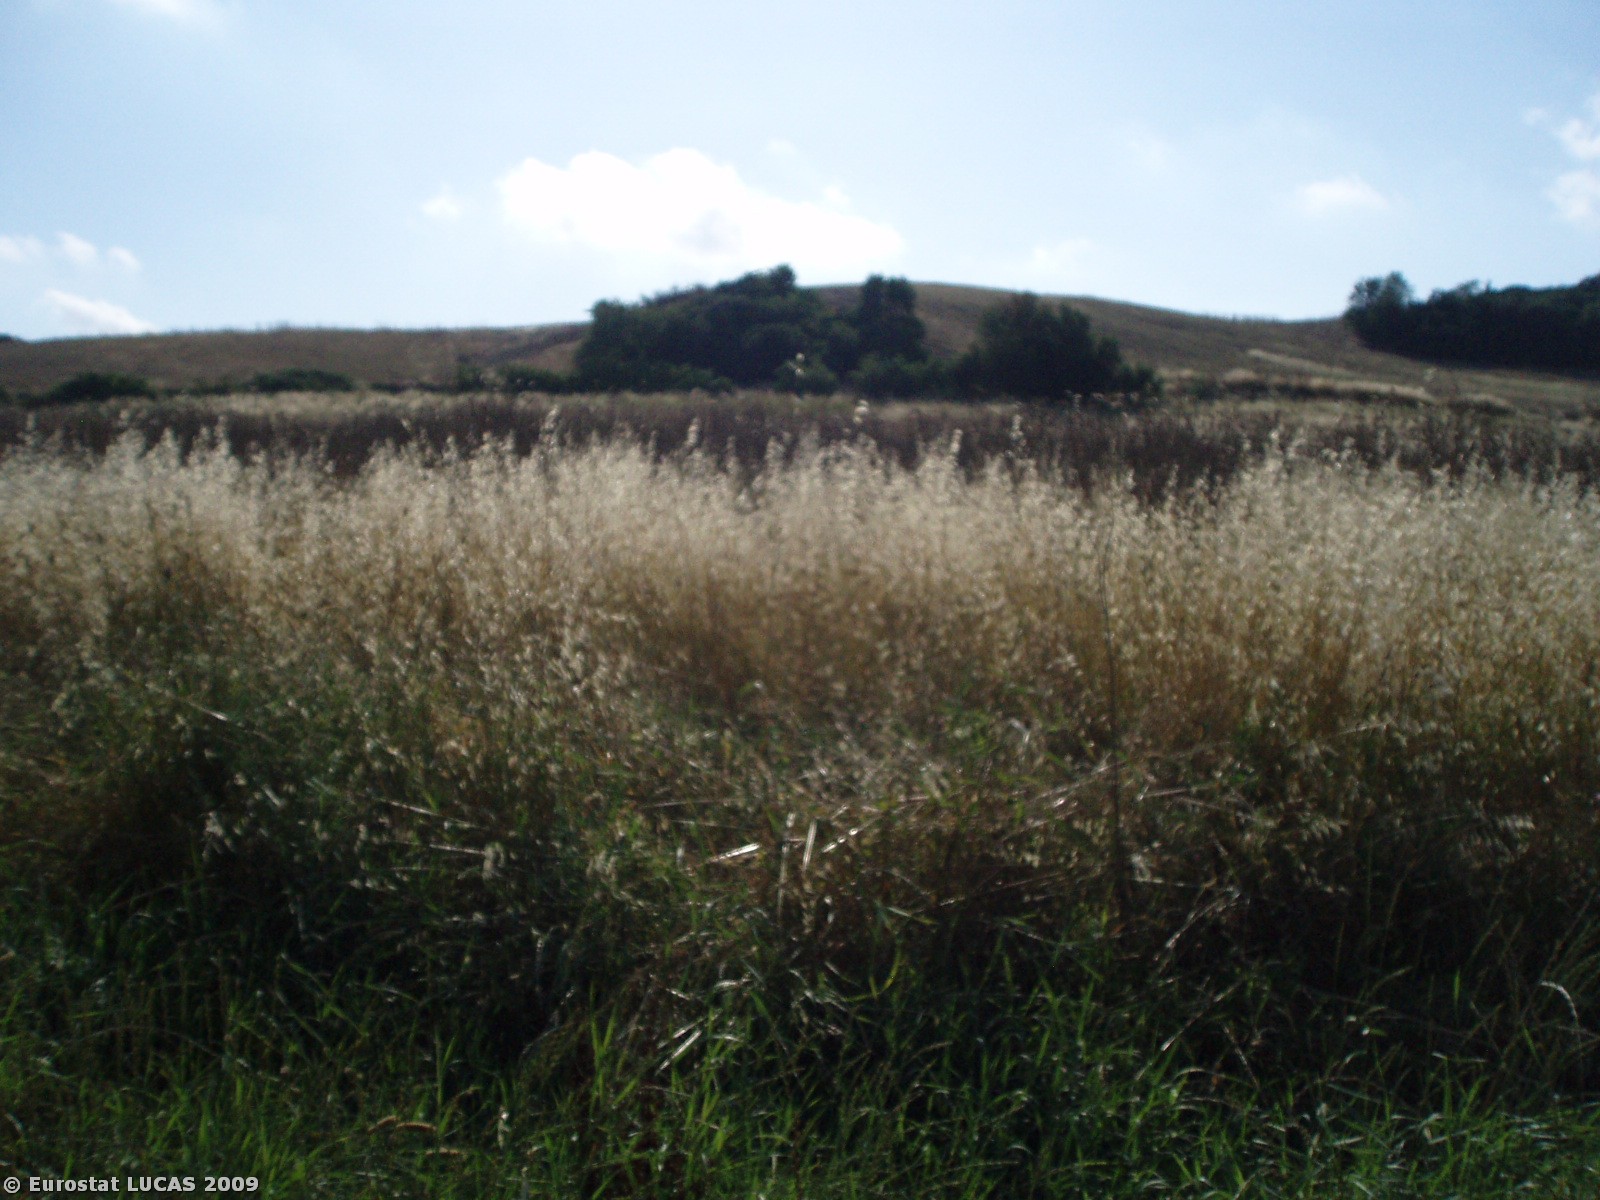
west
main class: Cropland
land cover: Temporary grasslands
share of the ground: > 75 %
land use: Agriculture (excluding fallow land and kitchen gardens)
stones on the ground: < 10 %
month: June
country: IT
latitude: 42.4605
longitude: 11.6118
